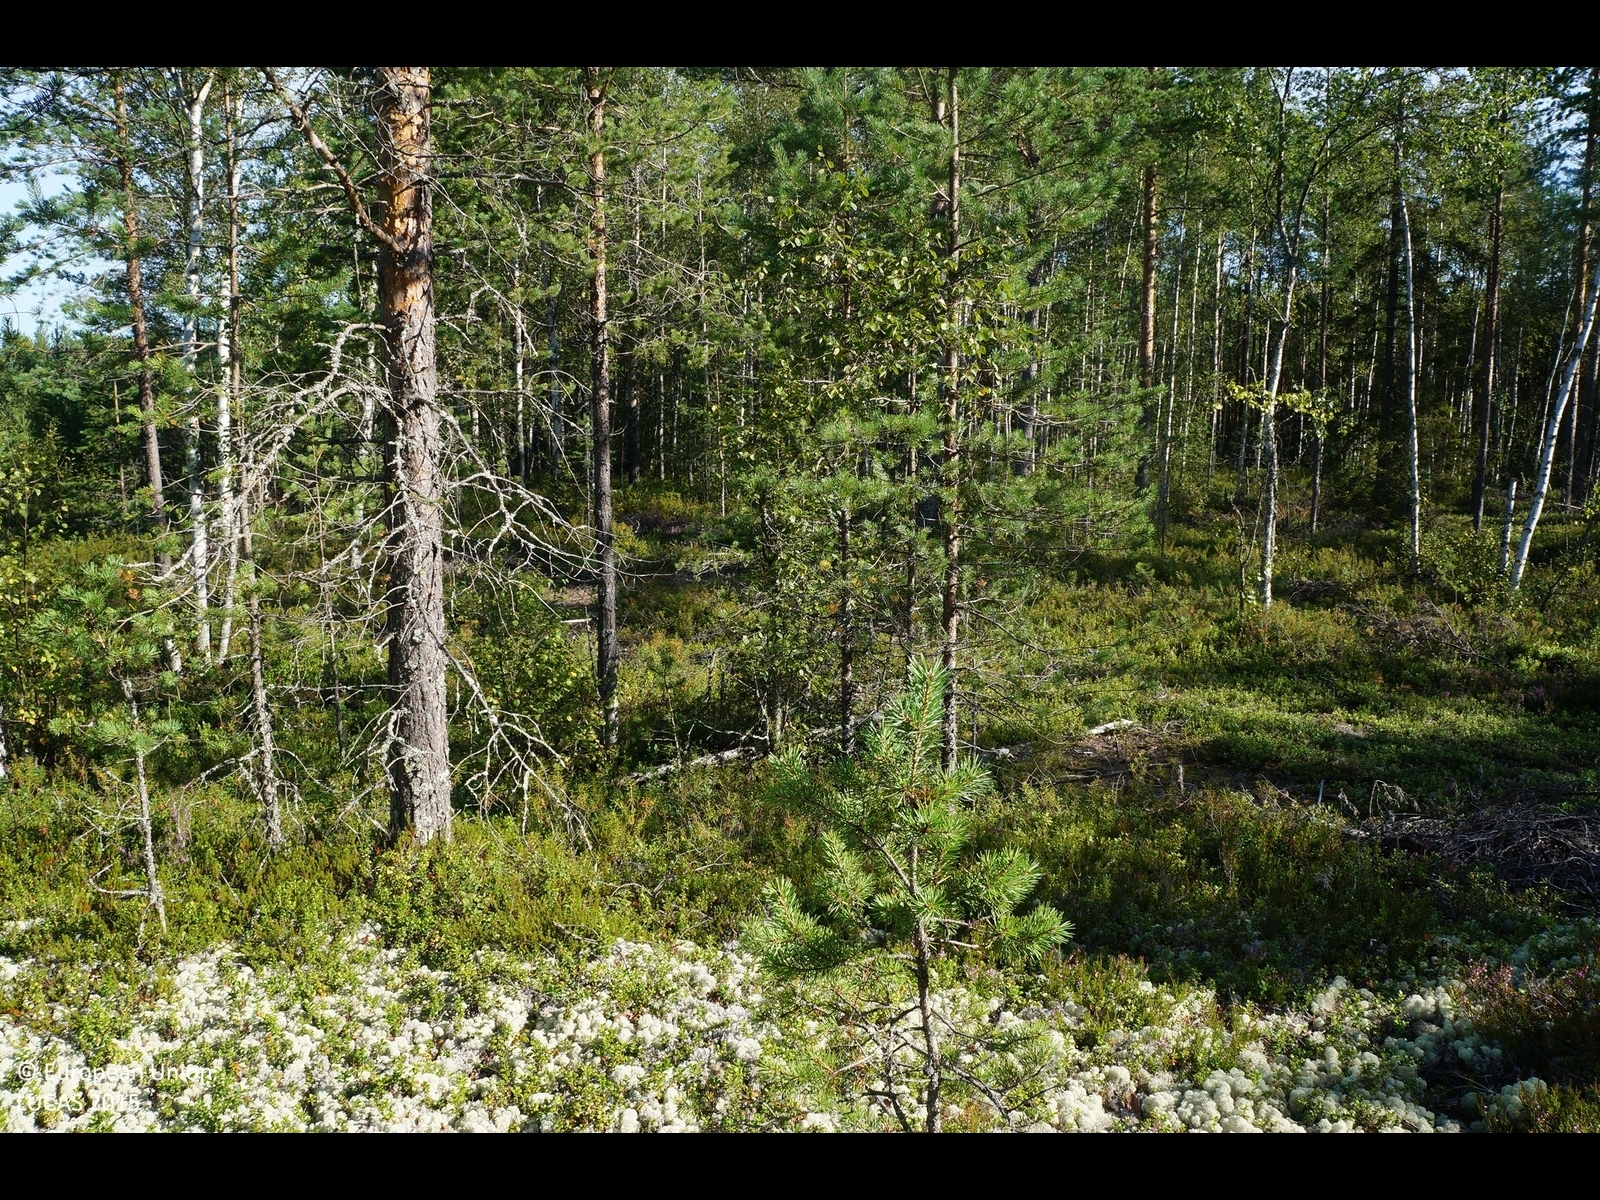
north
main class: Woodland
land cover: Pine dominated coniferous woodland
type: boreal forest
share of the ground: 25 - 50 %
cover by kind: coniferous forest trees 40 %, shrubs 30 %, lichens and mosses 30 %
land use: Forestry
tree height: > 5 m
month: August
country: FI
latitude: 64.8483
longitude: 24.9402
